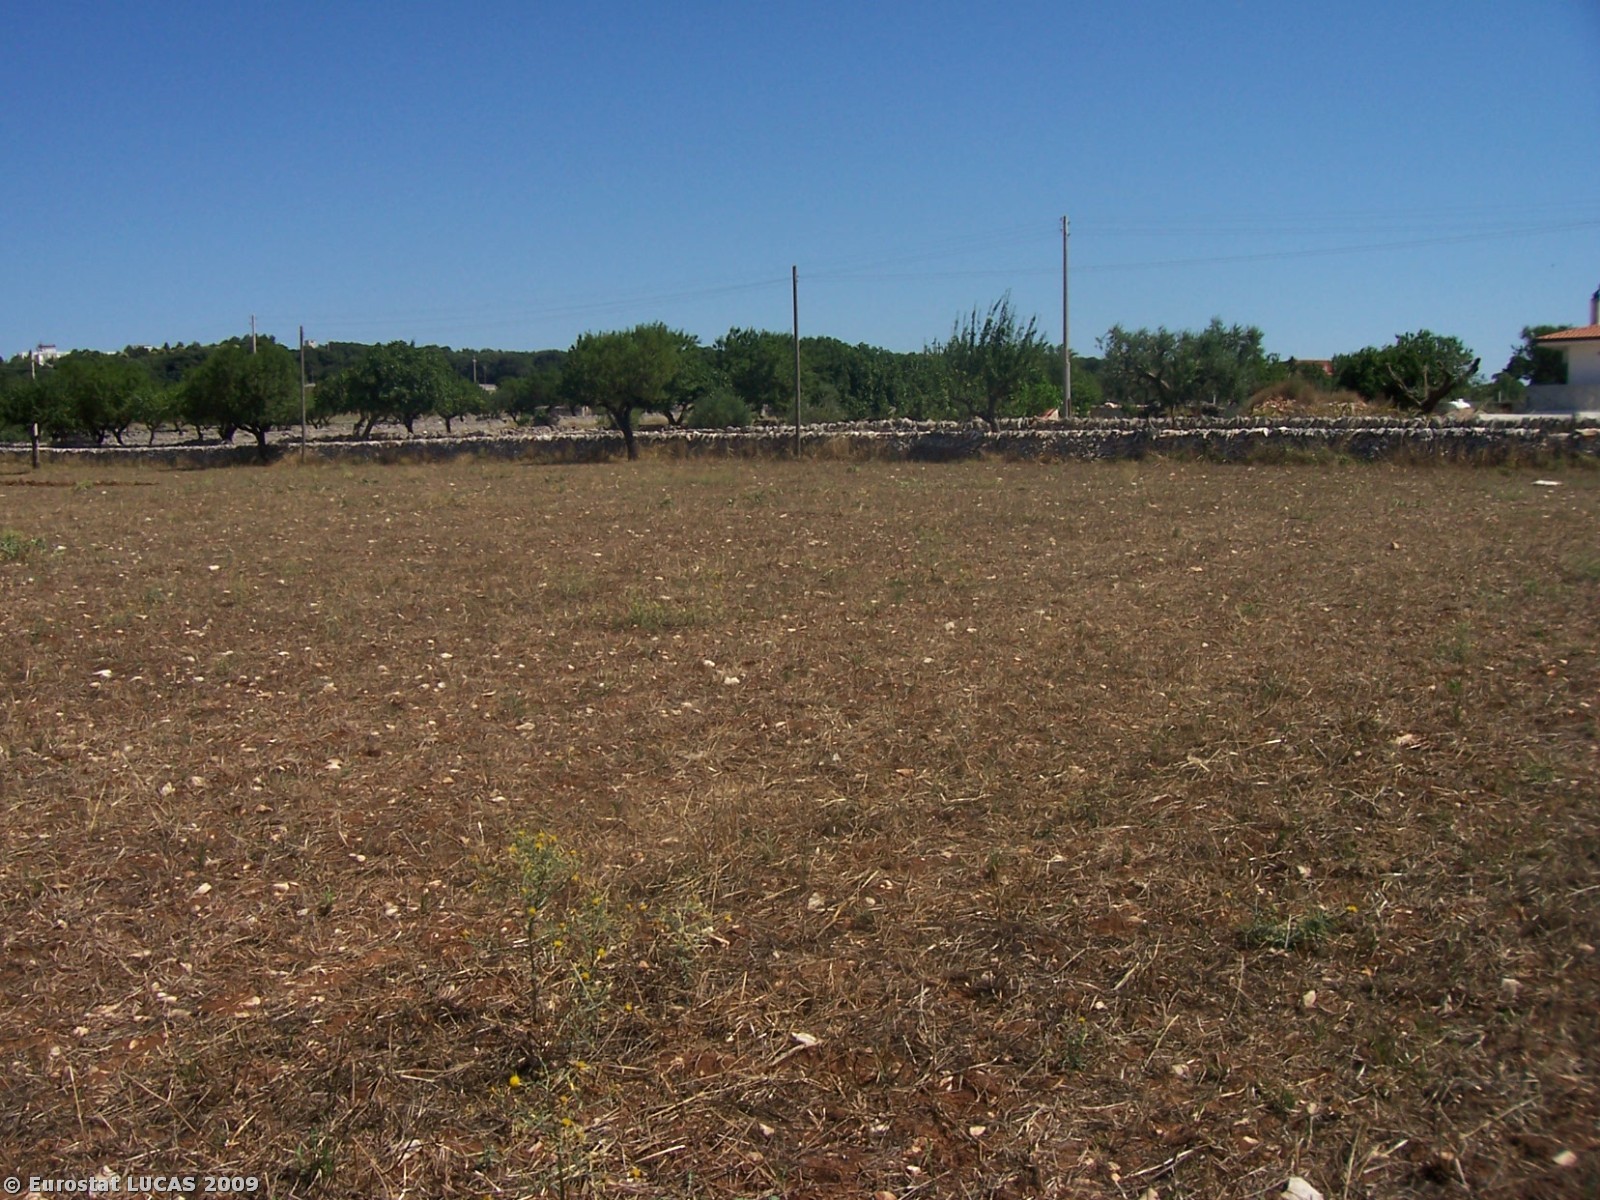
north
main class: Cropland
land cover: Temporary grasslands
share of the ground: 50 - 75 %
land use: Agriculture (excluding fallow land and kitchen gardens)
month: July
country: IT
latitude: 40.7416
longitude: 17.0234
